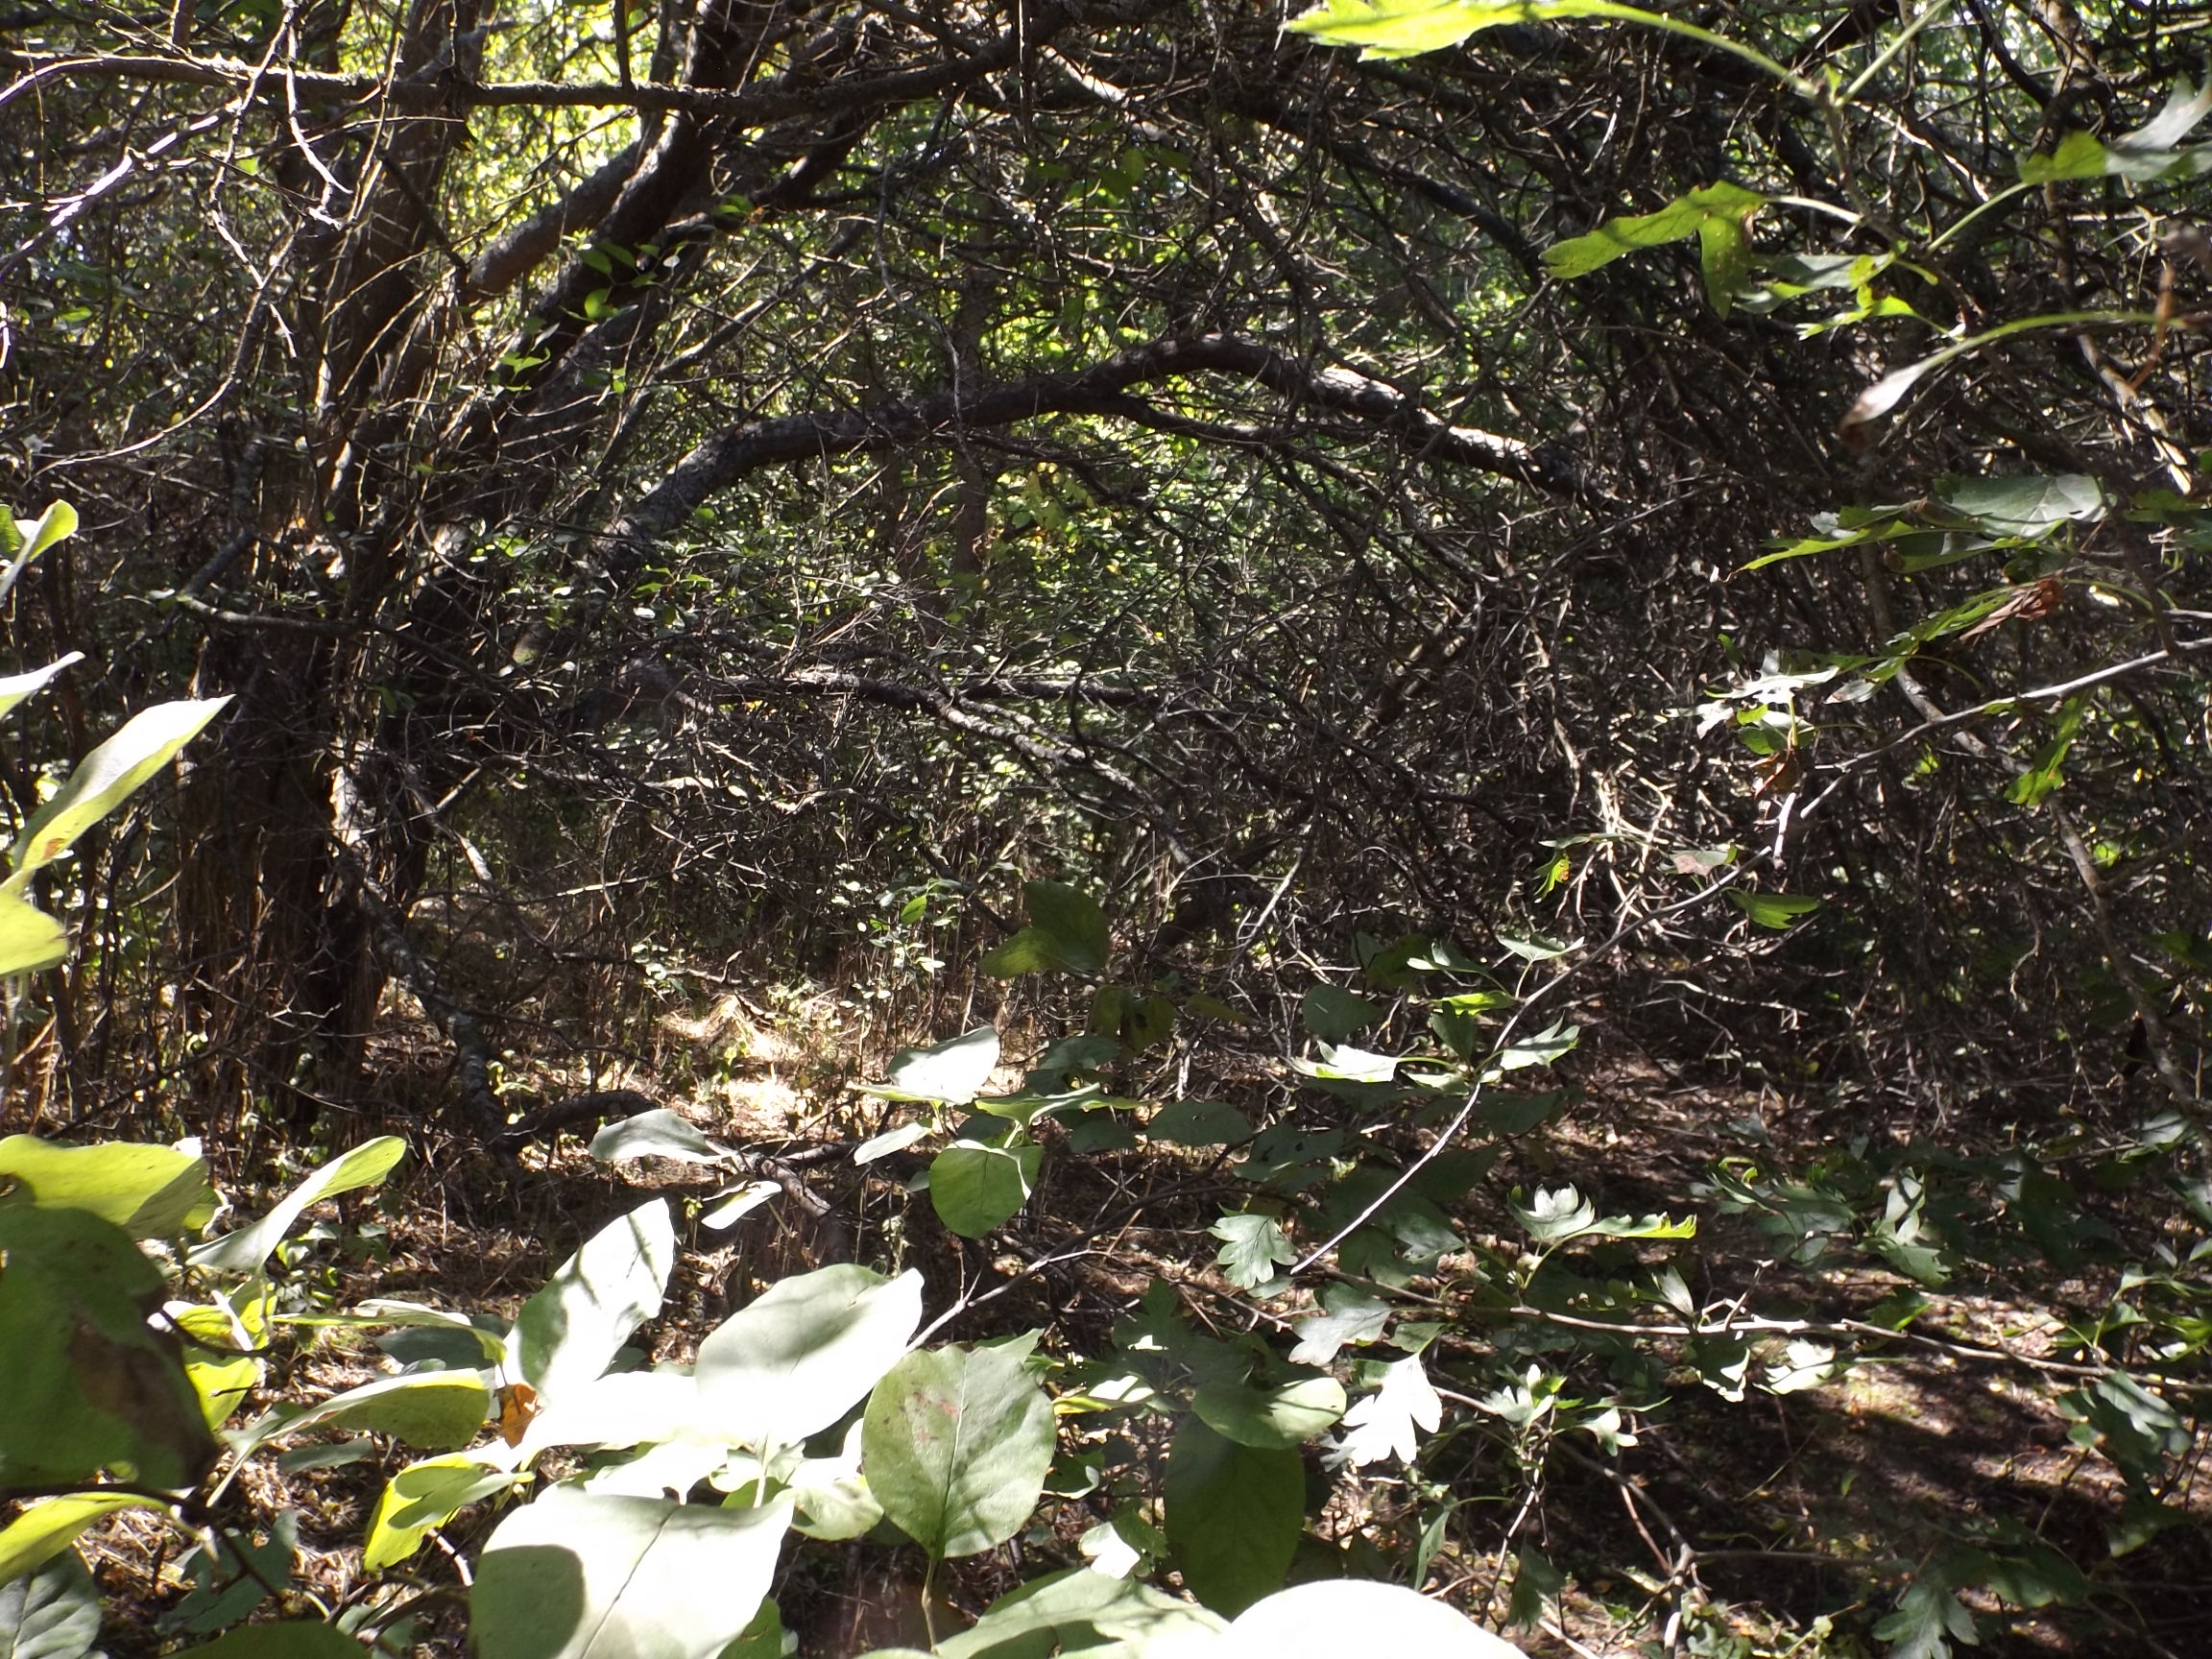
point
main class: Woodland
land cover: Broadleaved woodland
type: mesophytic deciduous forest
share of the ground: > 75 %
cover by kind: broadleaved forest trees 95 %, shrubs 5 %
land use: Forestry
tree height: > 5 m
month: September
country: BG
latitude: 43.3763
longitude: 27.6474
